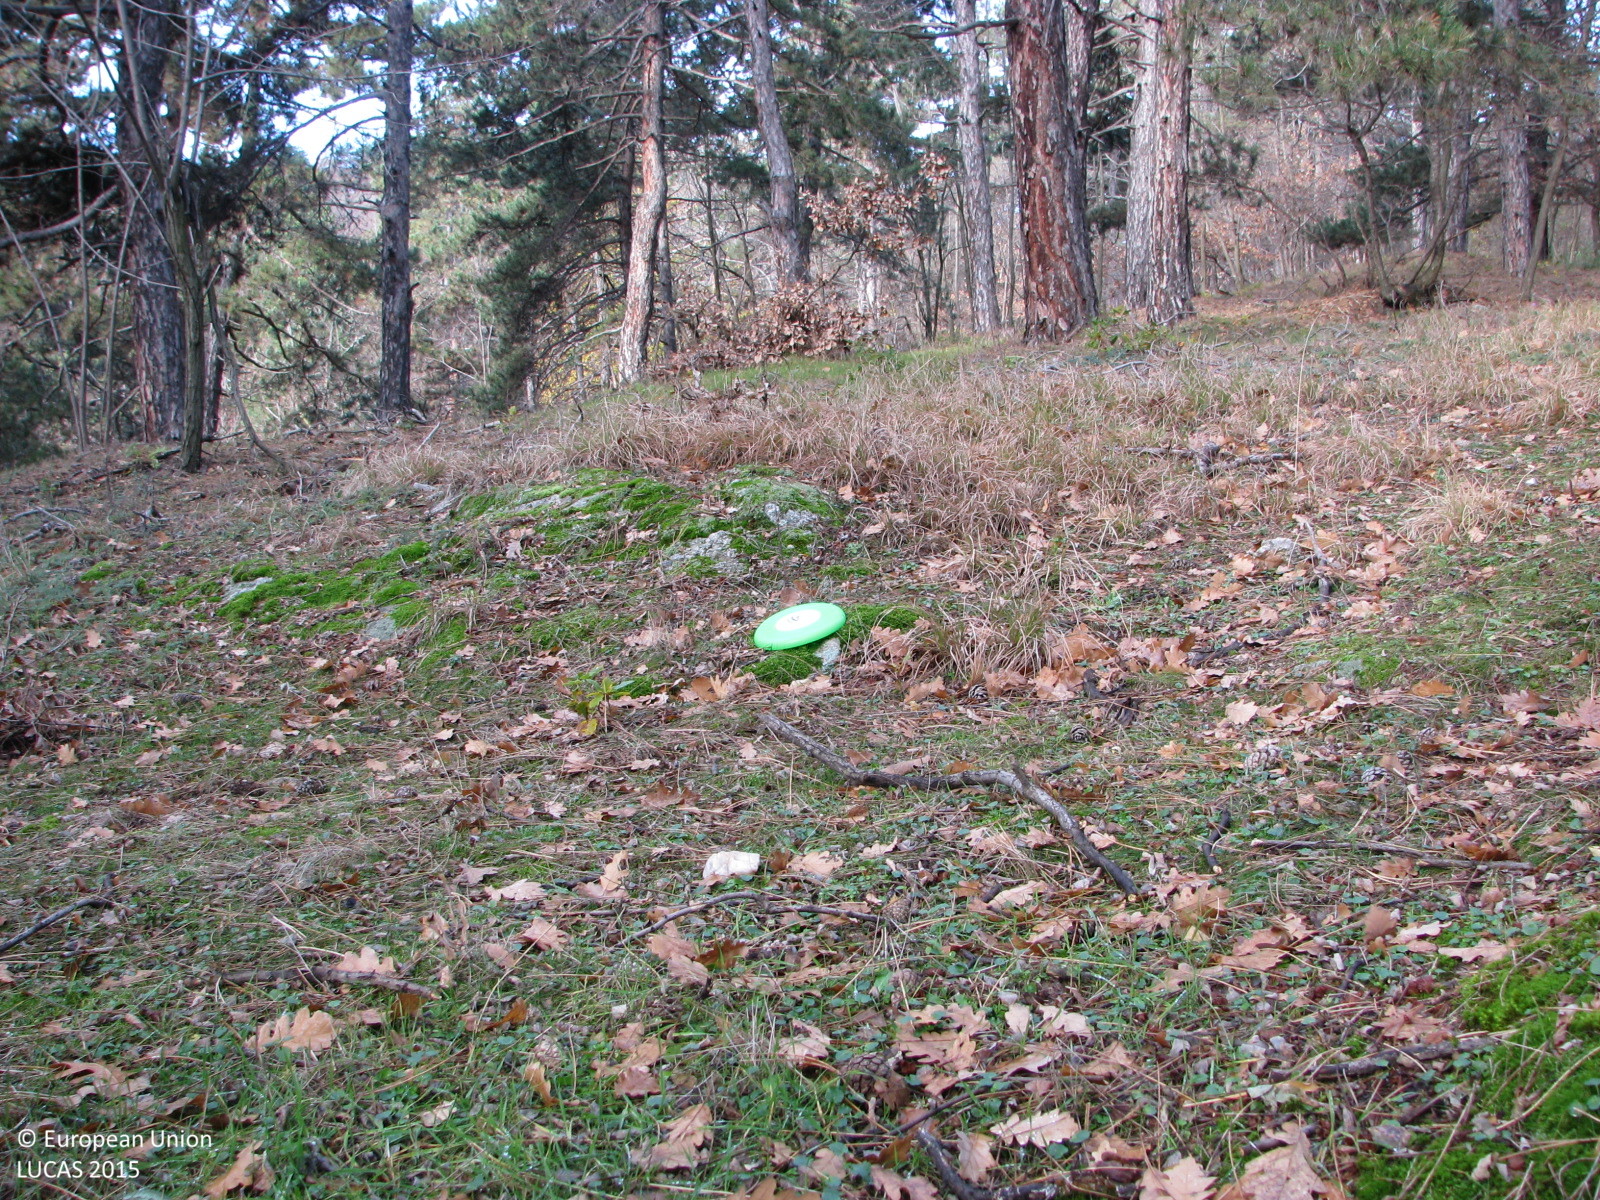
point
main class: Woodland
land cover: Pine dominated mixed woodland
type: hemiboreal forest and nemoral coniferous forest and mixed broadleaved-coniferous forest
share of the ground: 50 - 75 %
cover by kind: coniferous forest trees 40 %, herbaceous plants 25 %, broadleaved forest trees 20 %, unconsolidated bare surface 10 %, lichens and mosses 5 %
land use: Forestry
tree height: > 5 m
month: December
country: BG
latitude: 42.5123
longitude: 24.2999
